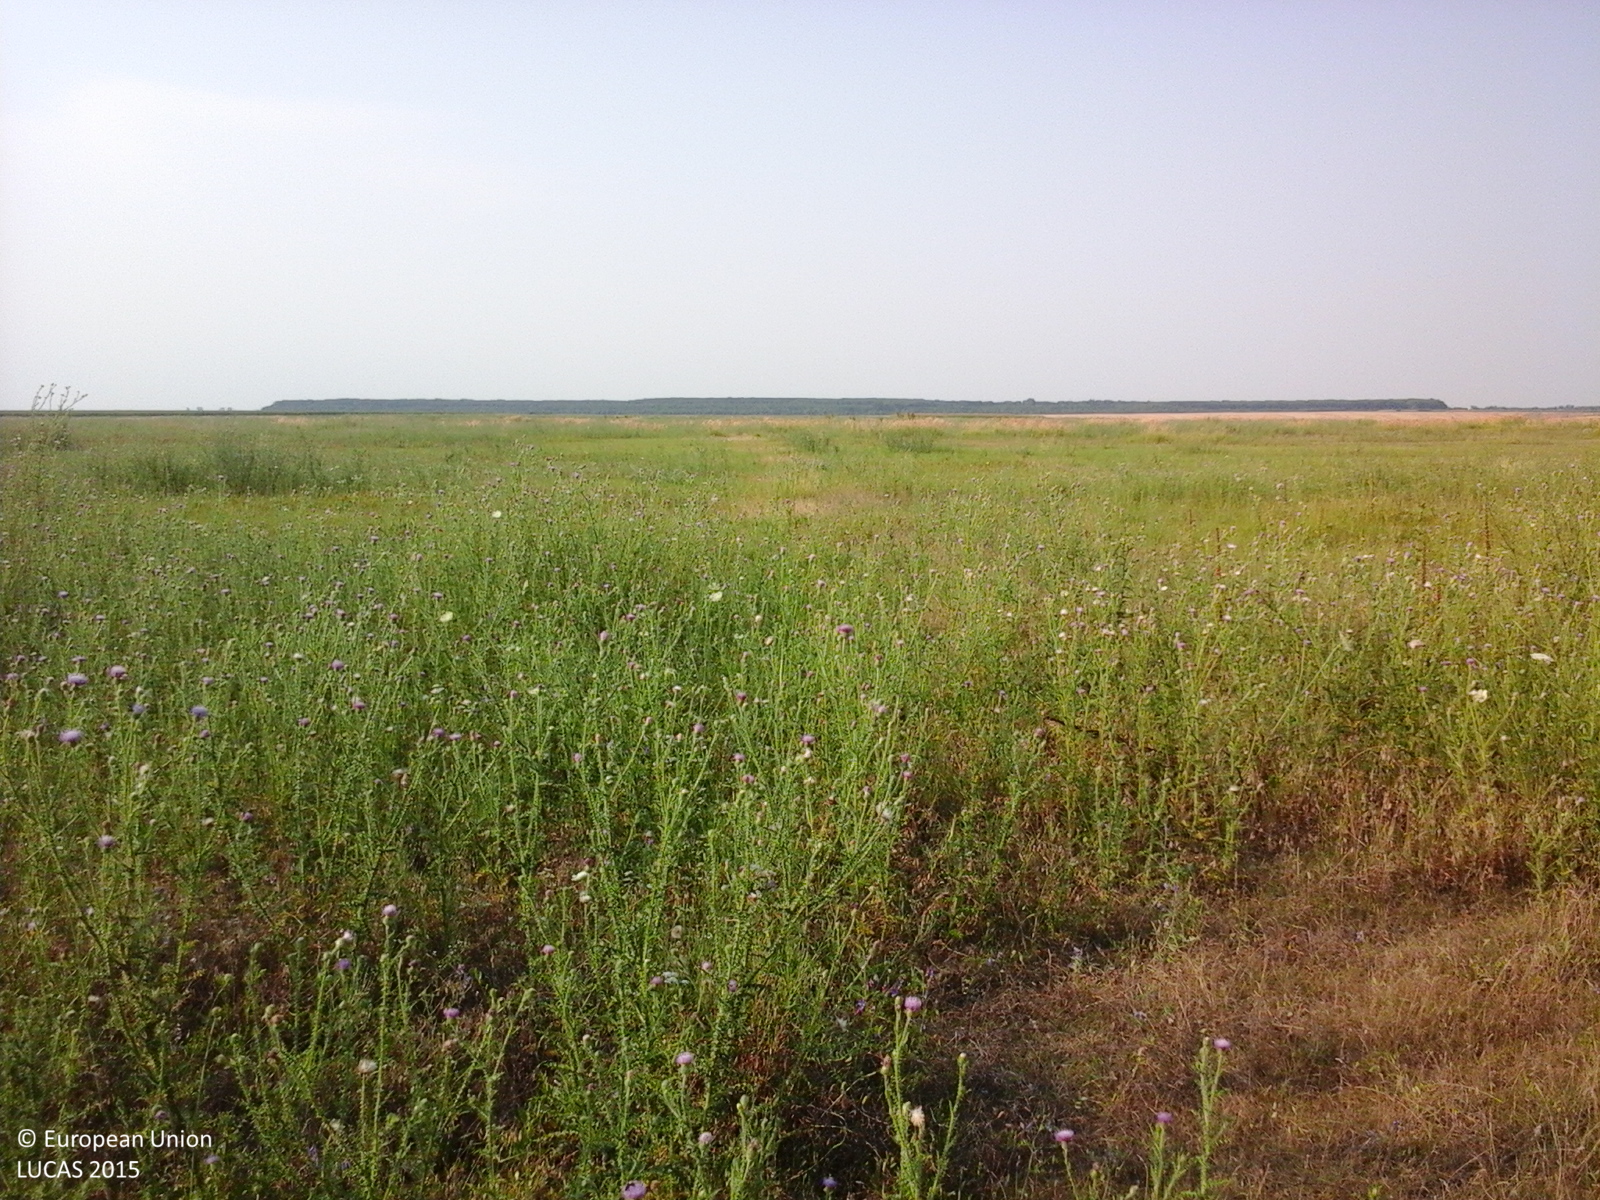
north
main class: Grassland
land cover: Spontaneously vegetated surfaces
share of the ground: > 75 %
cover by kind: herbaceous plants 100 %
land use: Fallow land
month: July
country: RO
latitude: 44.4753
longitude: 26.4704
